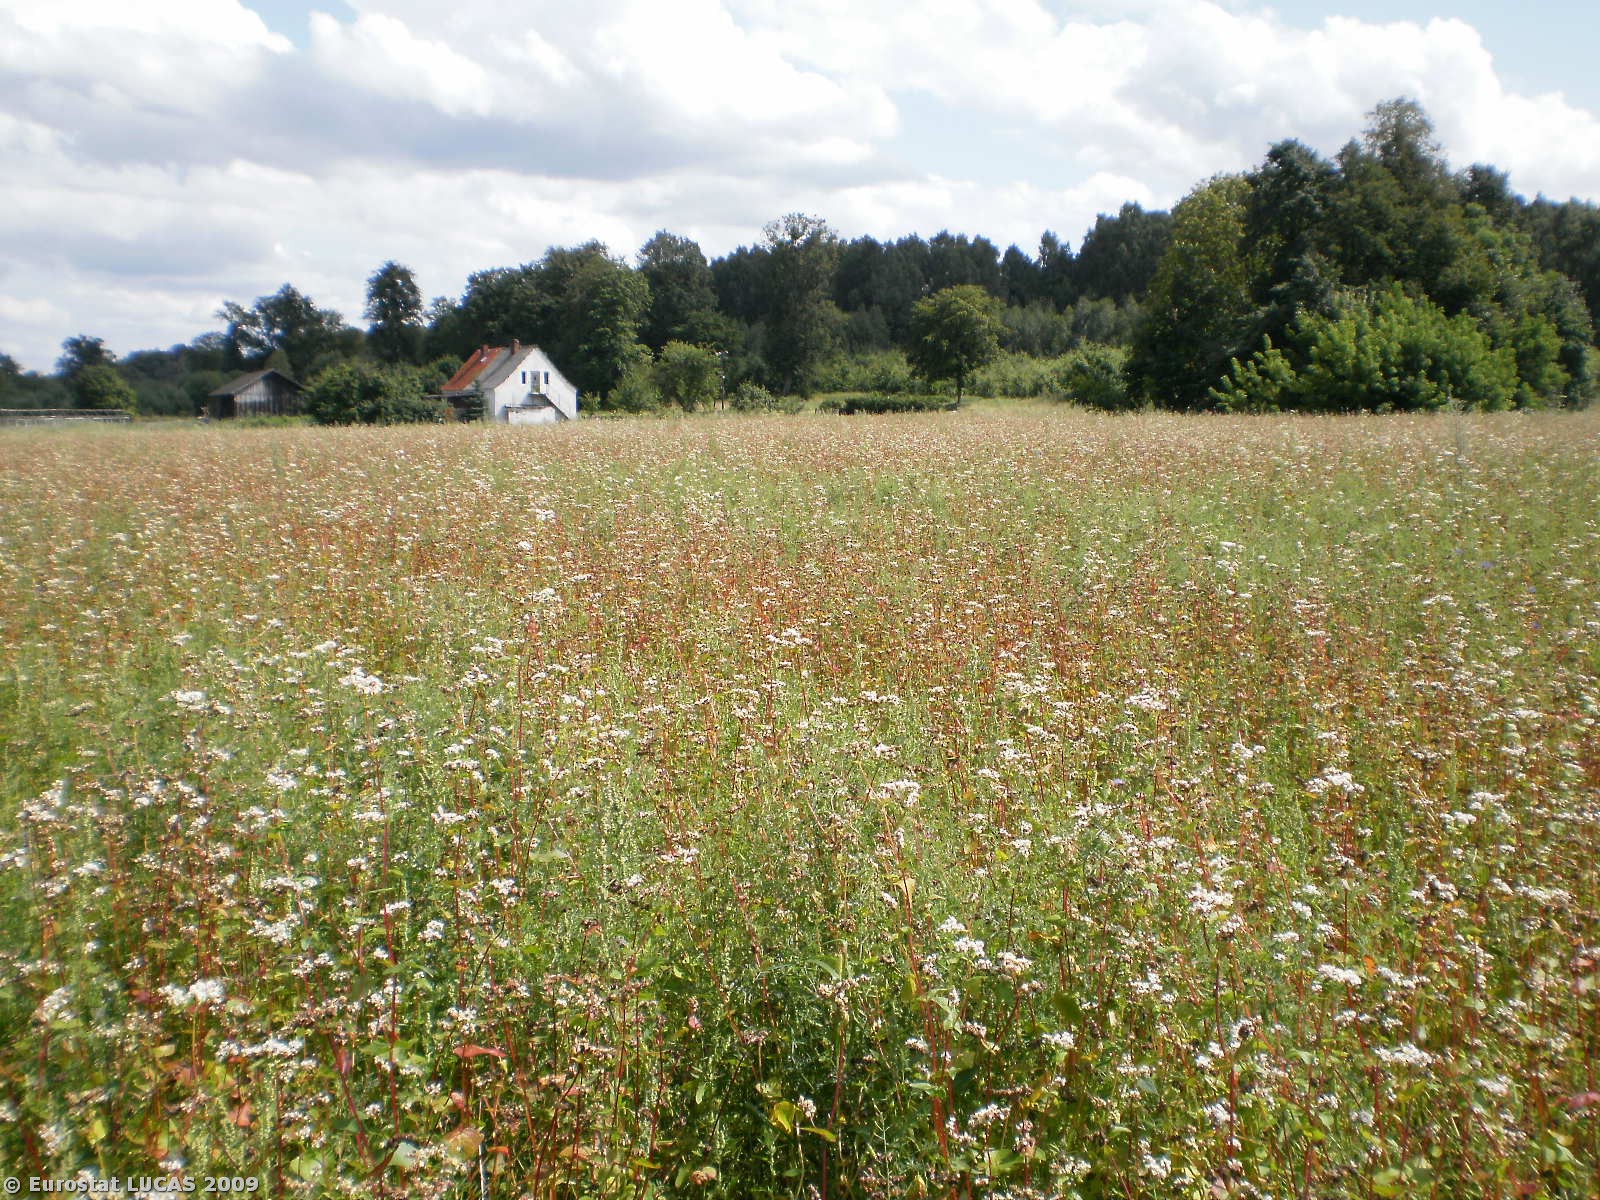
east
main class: Cropland
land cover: Other cereals
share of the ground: > 75 %
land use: Agriculture (excluding fallow land and kitchen gardens)
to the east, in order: Other cereals; Grassland without tree/shrub cover; Artificial constructions in urban areas; Grassland with sparse tree/shrub cover
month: July
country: PL
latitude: 53.4010
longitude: 20.4599
